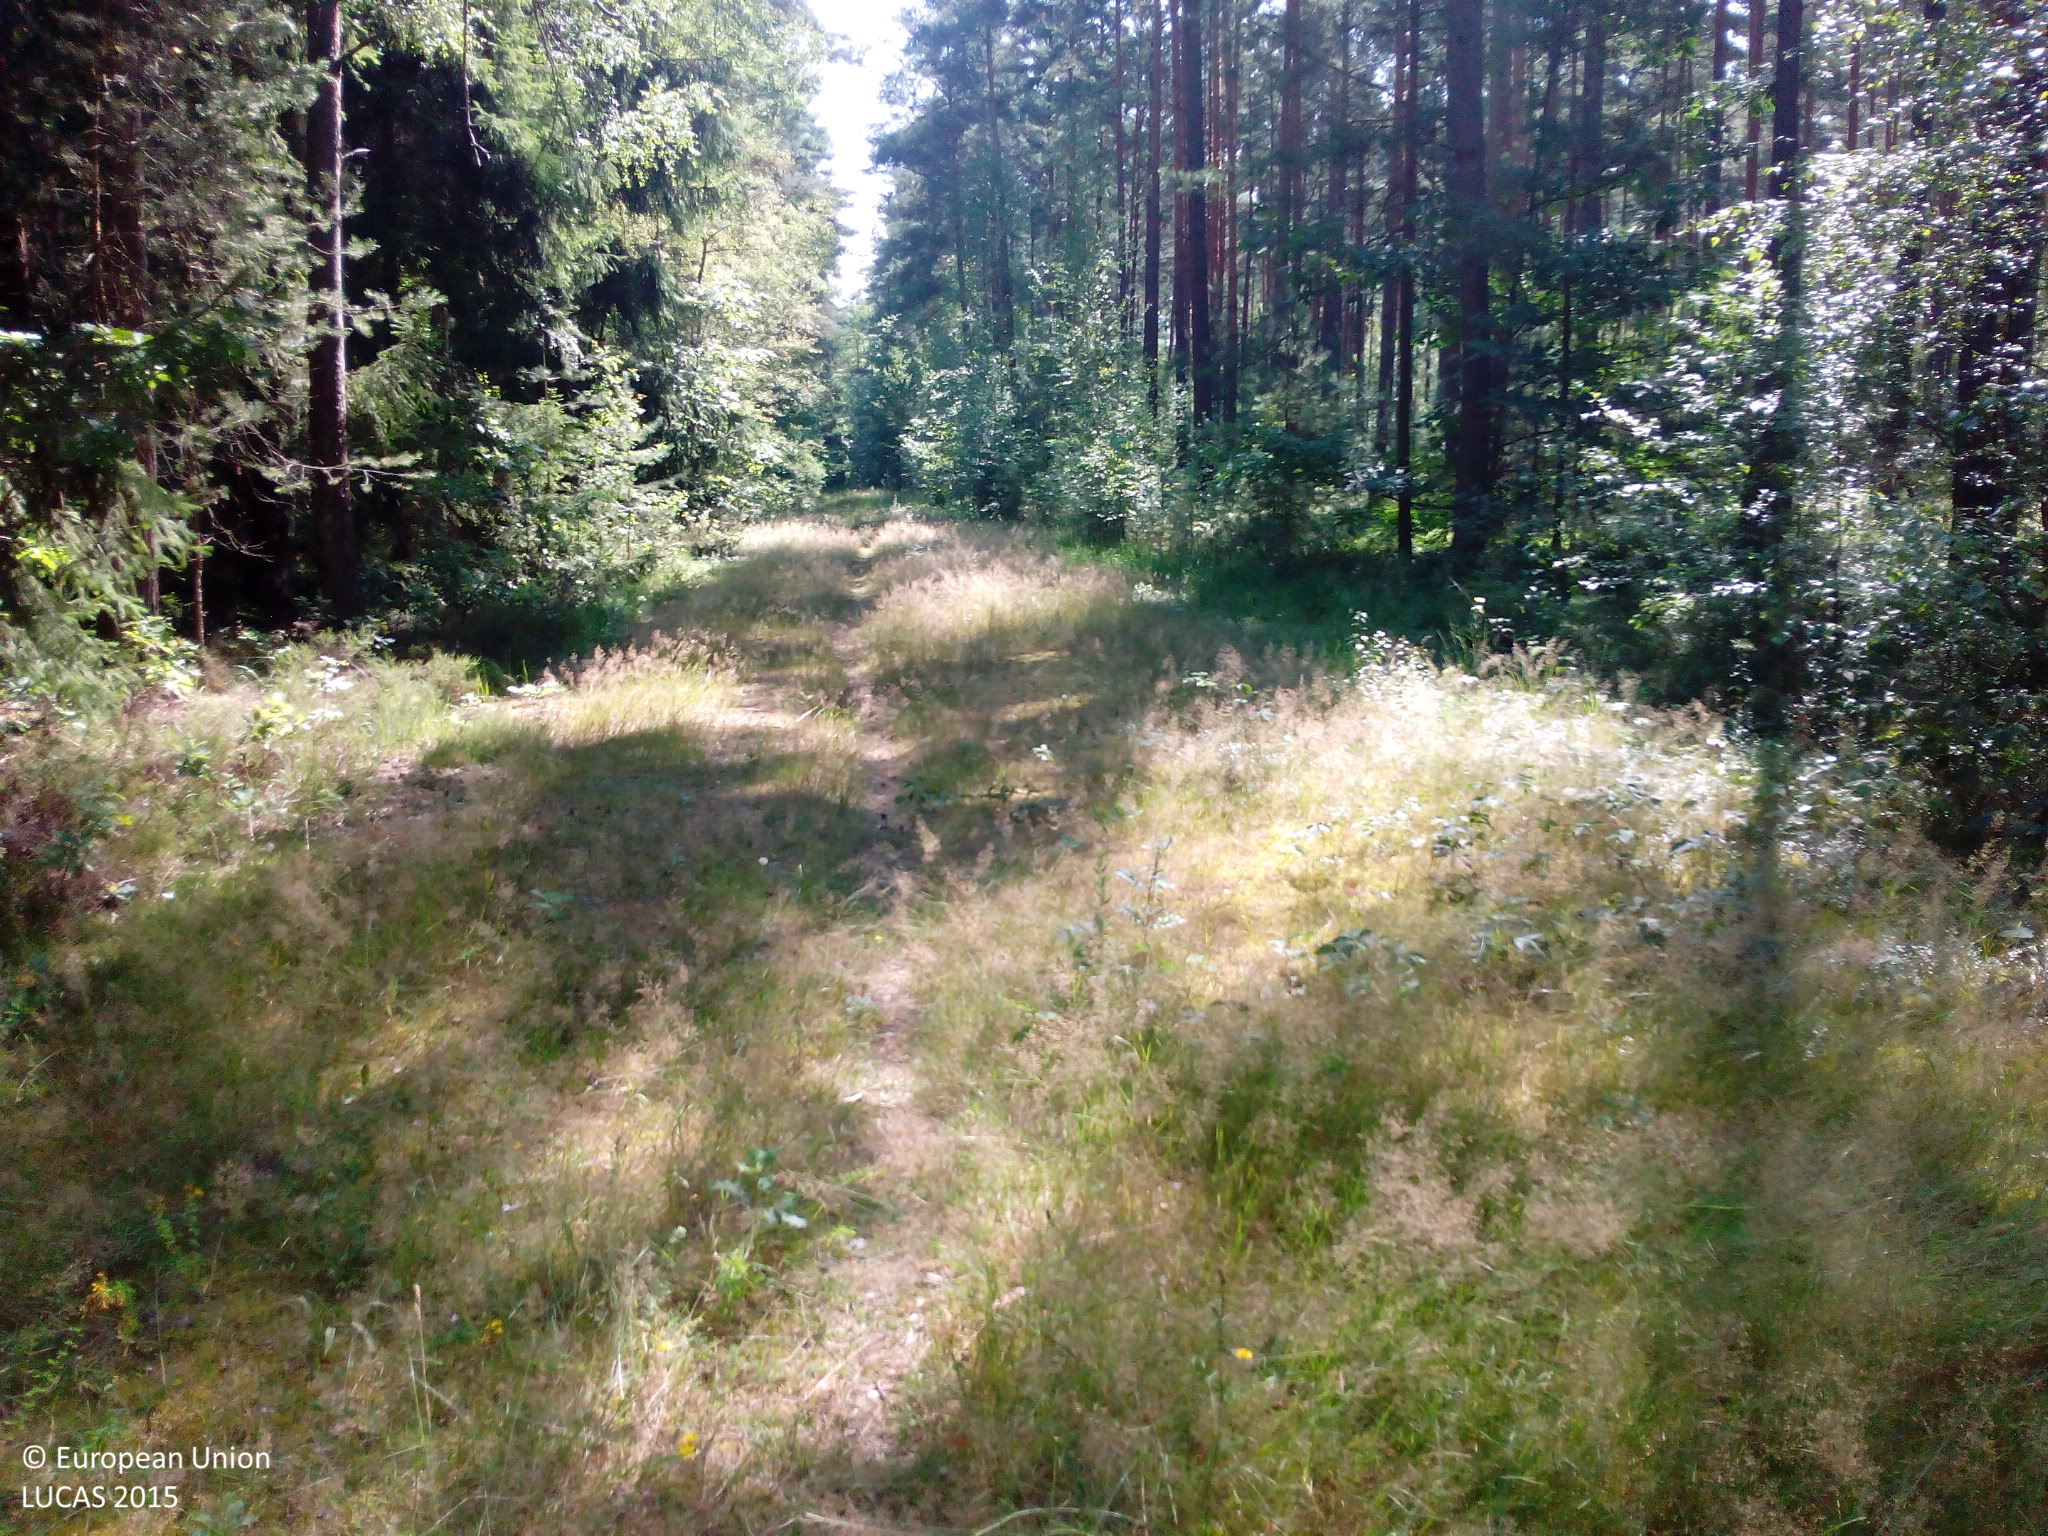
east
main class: Woodland
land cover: Pine dominated coniferous woodland
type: hemiboreal forest and nemoral coniferous forest and mixed broadleaved-coniferous forest
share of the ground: > 75 %
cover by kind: coniferous forest trees 65 %, broadleaved forest trees 15 %, shrubs 10 %, herbaceous plants 10 %
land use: Forestry
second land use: Amenities, museums, leisure
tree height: > 5 m
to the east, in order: Pine dominated coniferous woodland; Tracks; Pine dominated mixed woodland; Tracks; Pine dominated mixed woodland; Pine dominated coniferous woodland
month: July
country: DE
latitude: 49.5857
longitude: 11.0647
